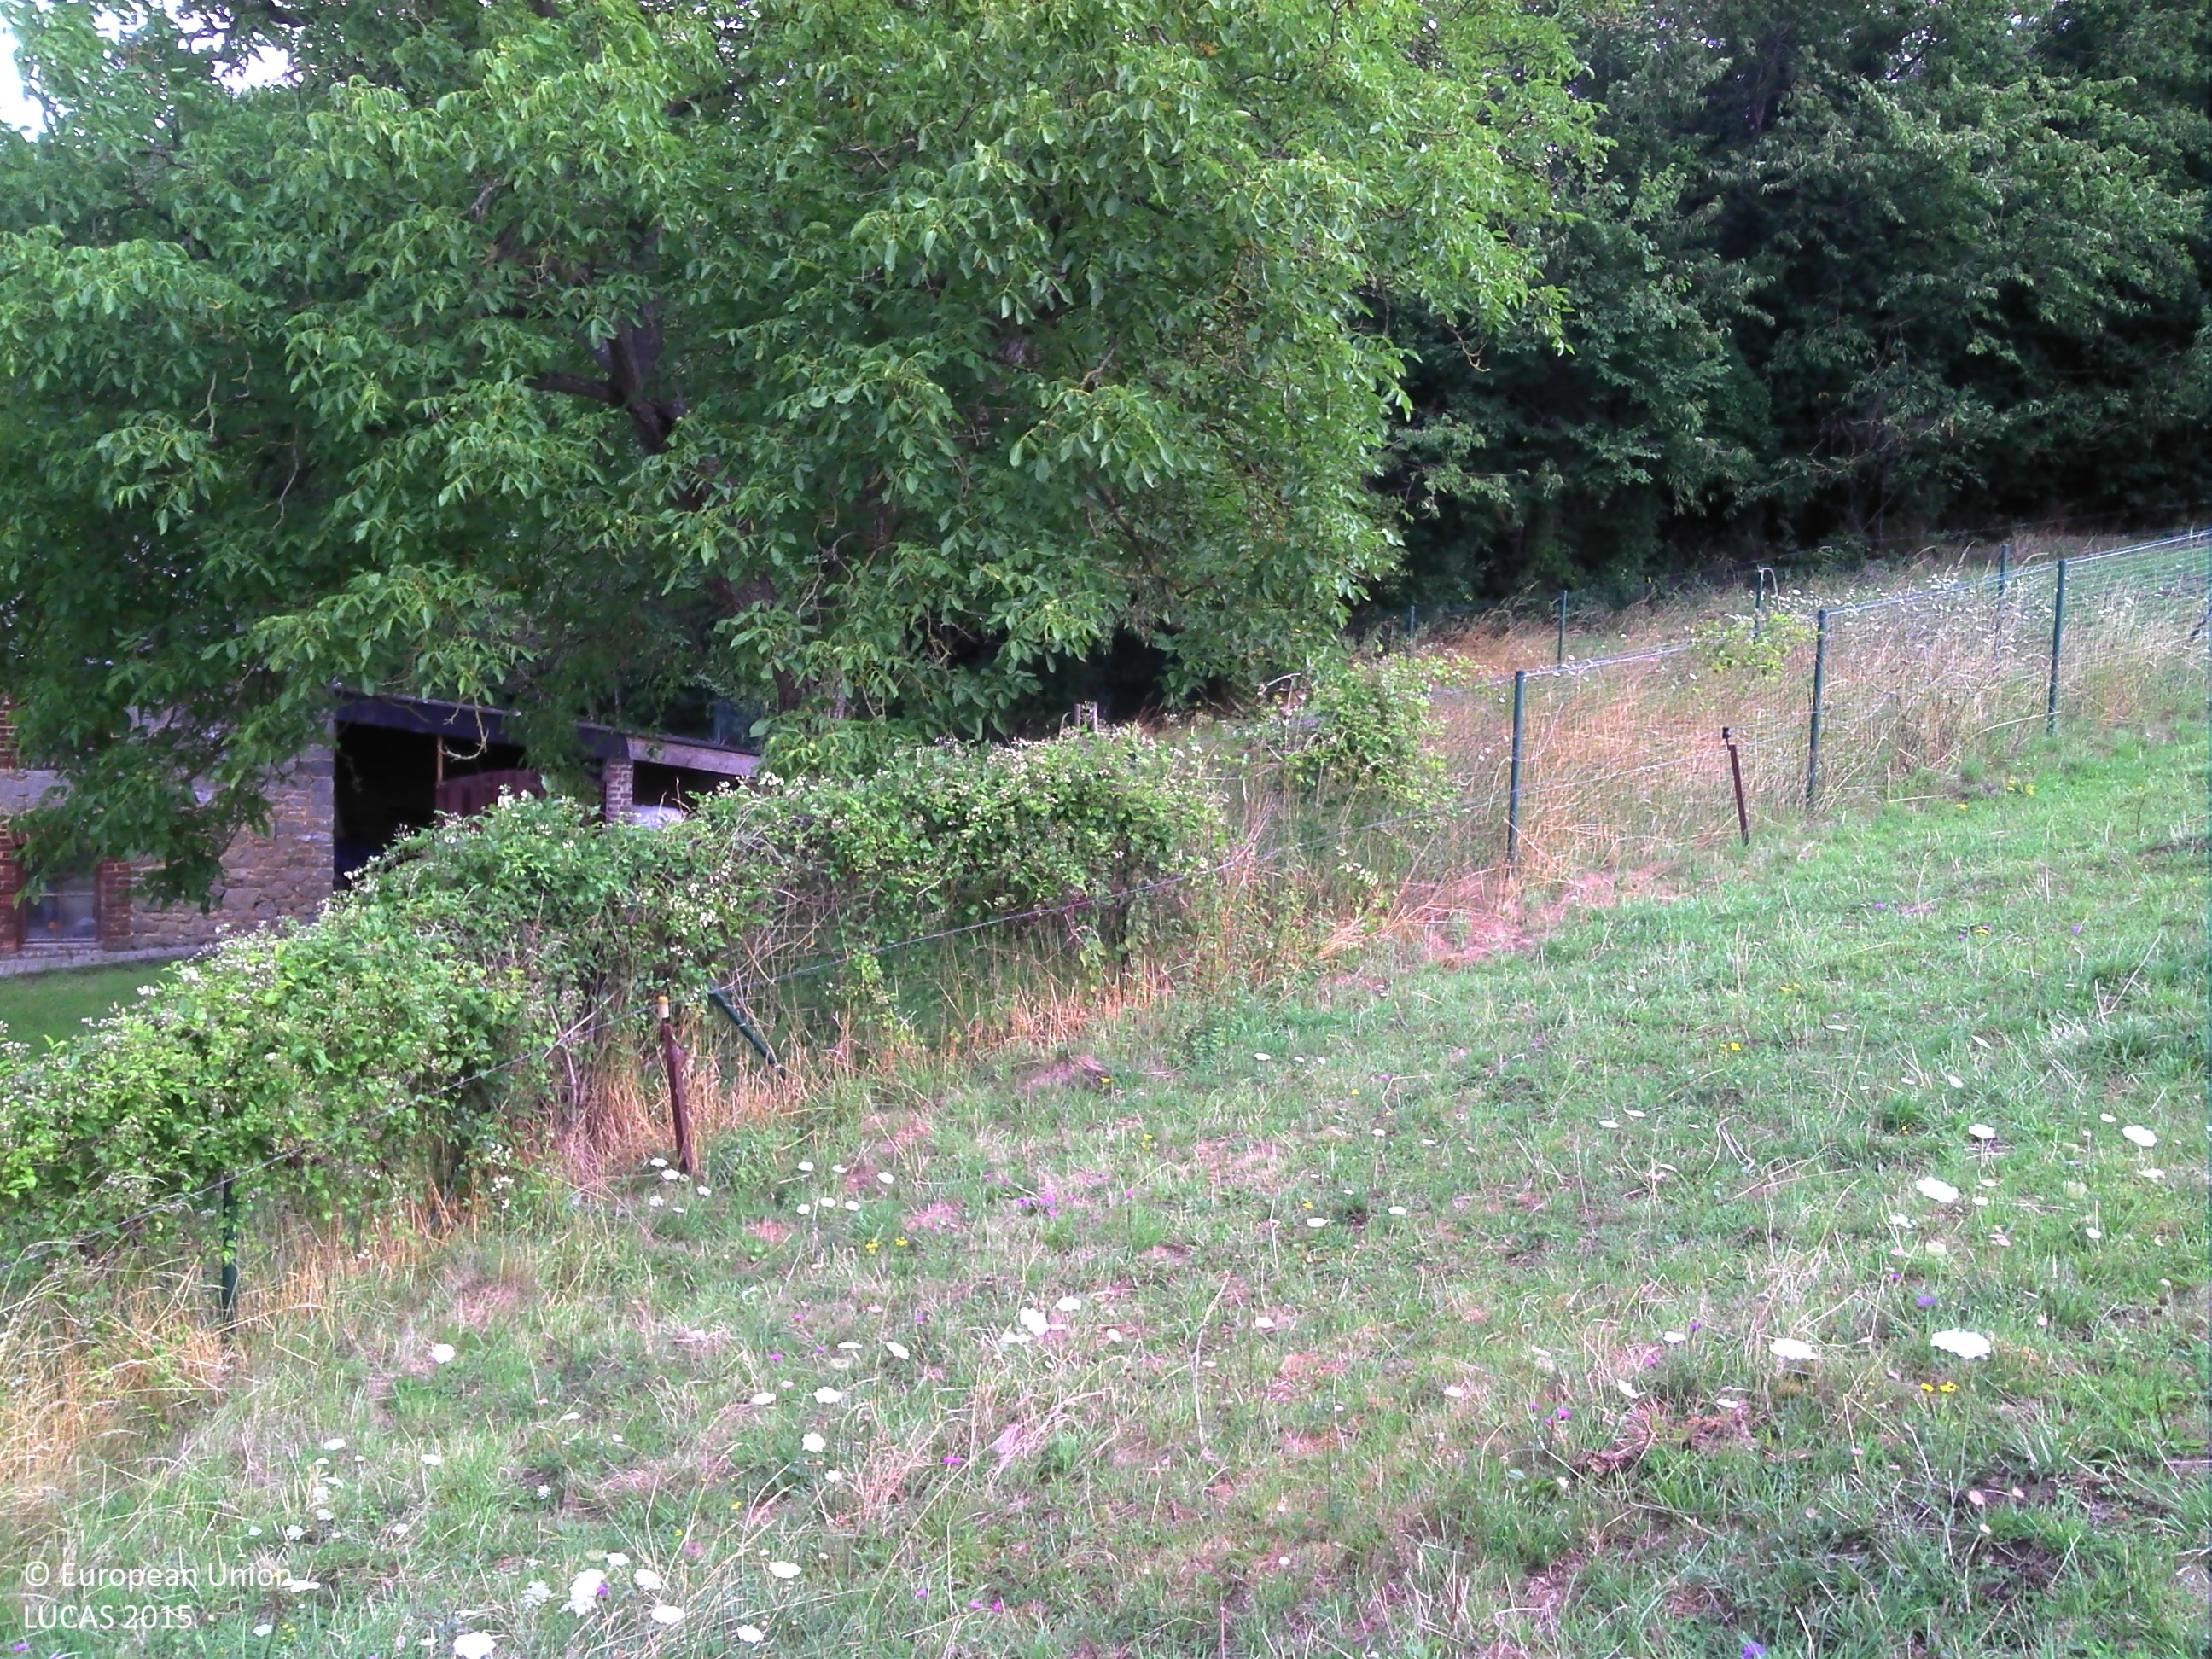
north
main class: Grassland
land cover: Grassland without tree/shrub cover
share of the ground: > 75 %
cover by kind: herbaceous plants 100 %
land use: Agriculture (excluding fallow land and kitchen gardens)
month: July
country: BE
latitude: 50.5162
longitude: 5.2167
